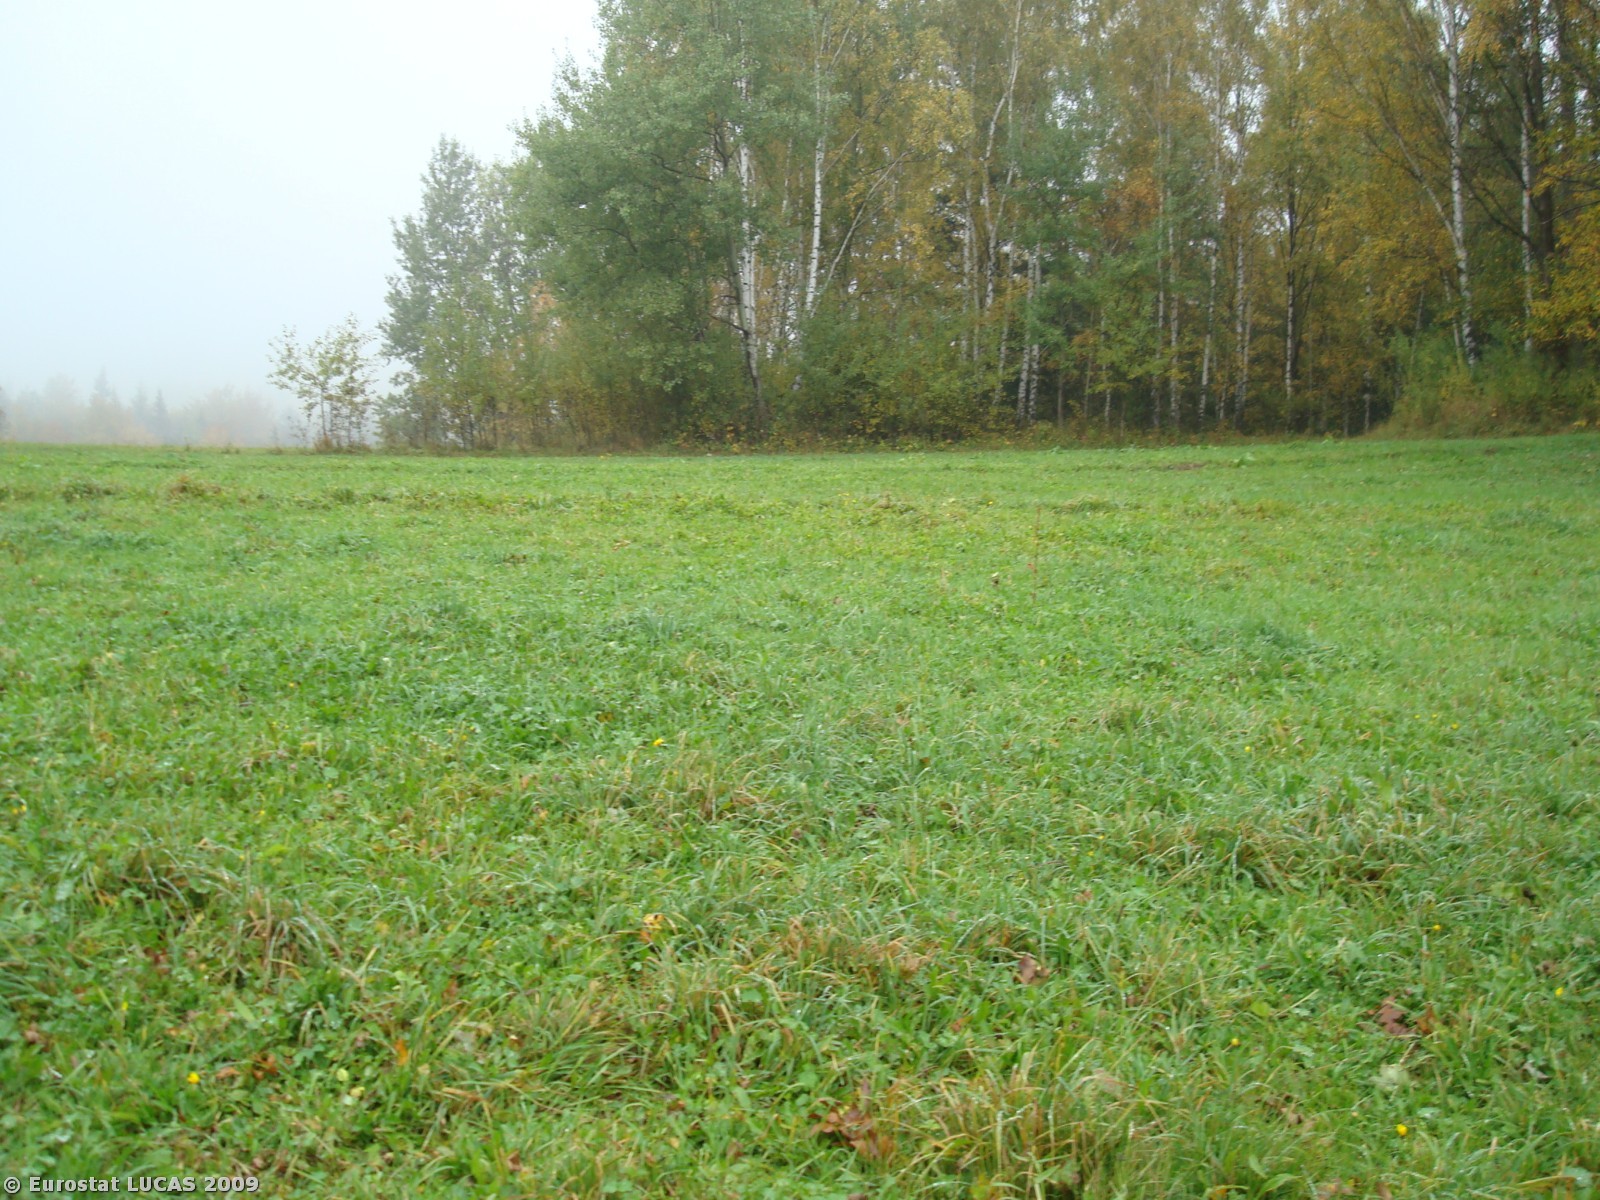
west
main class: Grassland
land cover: Grassland without tree/shrub cover
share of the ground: > 75 %
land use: Unused
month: September
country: PL
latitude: 49.6493
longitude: 19.6263
